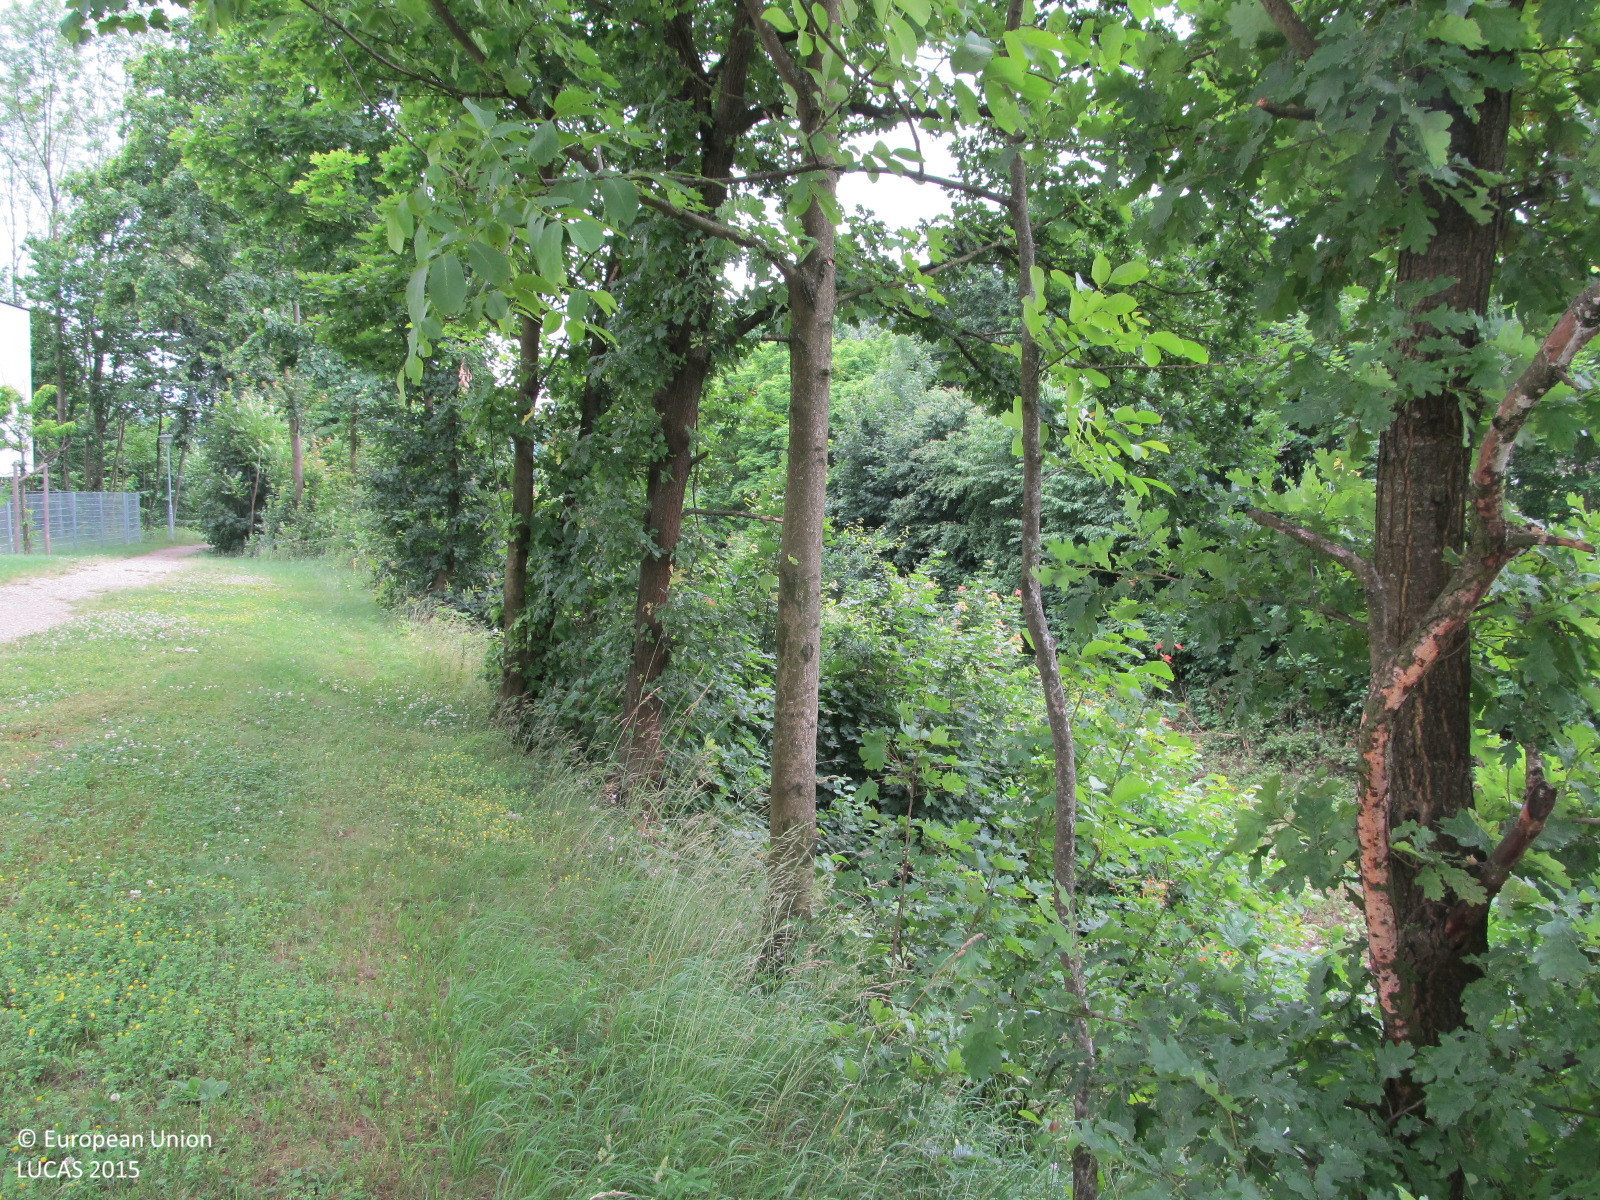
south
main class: Woodland
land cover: Broadleaved woodland
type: hemiboreal forest and nemoral coniferous forest and mixed broadleaved-coniferous forest
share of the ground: > 75 %
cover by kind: broadleaved forest trees 80 %, shrubs 20 %
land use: Forestry
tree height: < 5 m
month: June
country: AT
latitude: 48.2068
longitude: 15.6139
